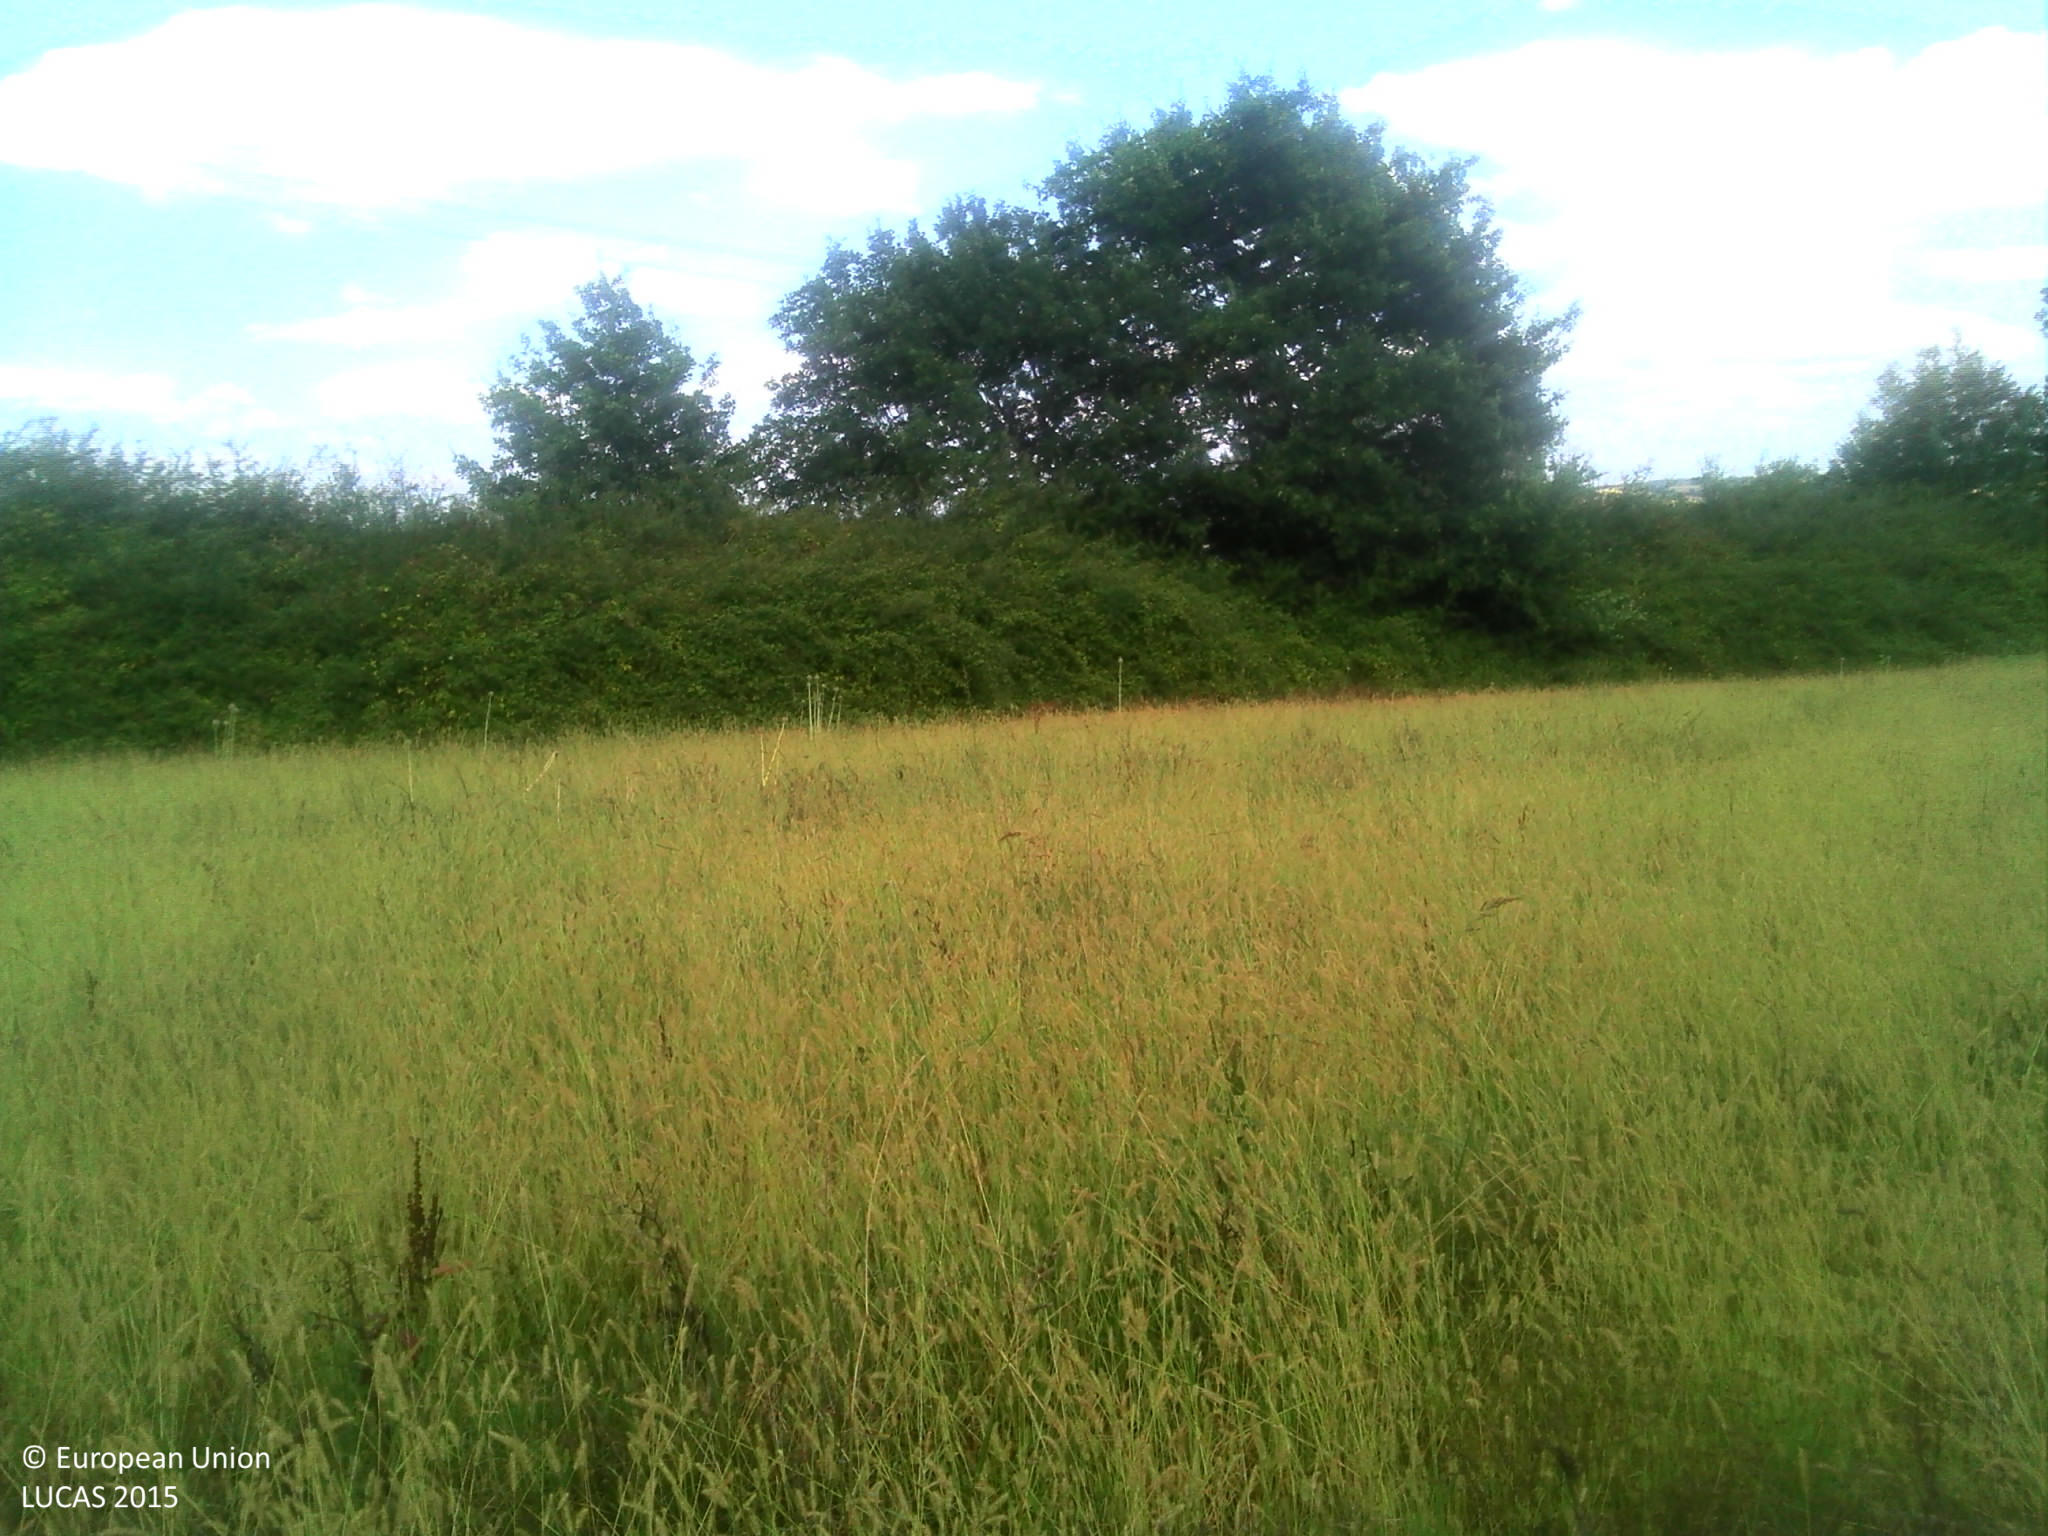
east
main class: Grassland
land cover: Spontaneously vegetated surfaces
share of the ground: > 75 %
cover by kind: herbaceous plants 100 %
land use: Fallow land
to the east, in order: Spontaneously vegetated surfaces; Broadleaved woodland; Electric lines; Maize; Broadleaved woodland; Tracks; Grass margins; Fences; Sunflower; Grassland without tree/shrub cover; Broadleaved woodland; Common wheat
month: July
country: FR
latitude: 44.0521
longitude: 0.6217
